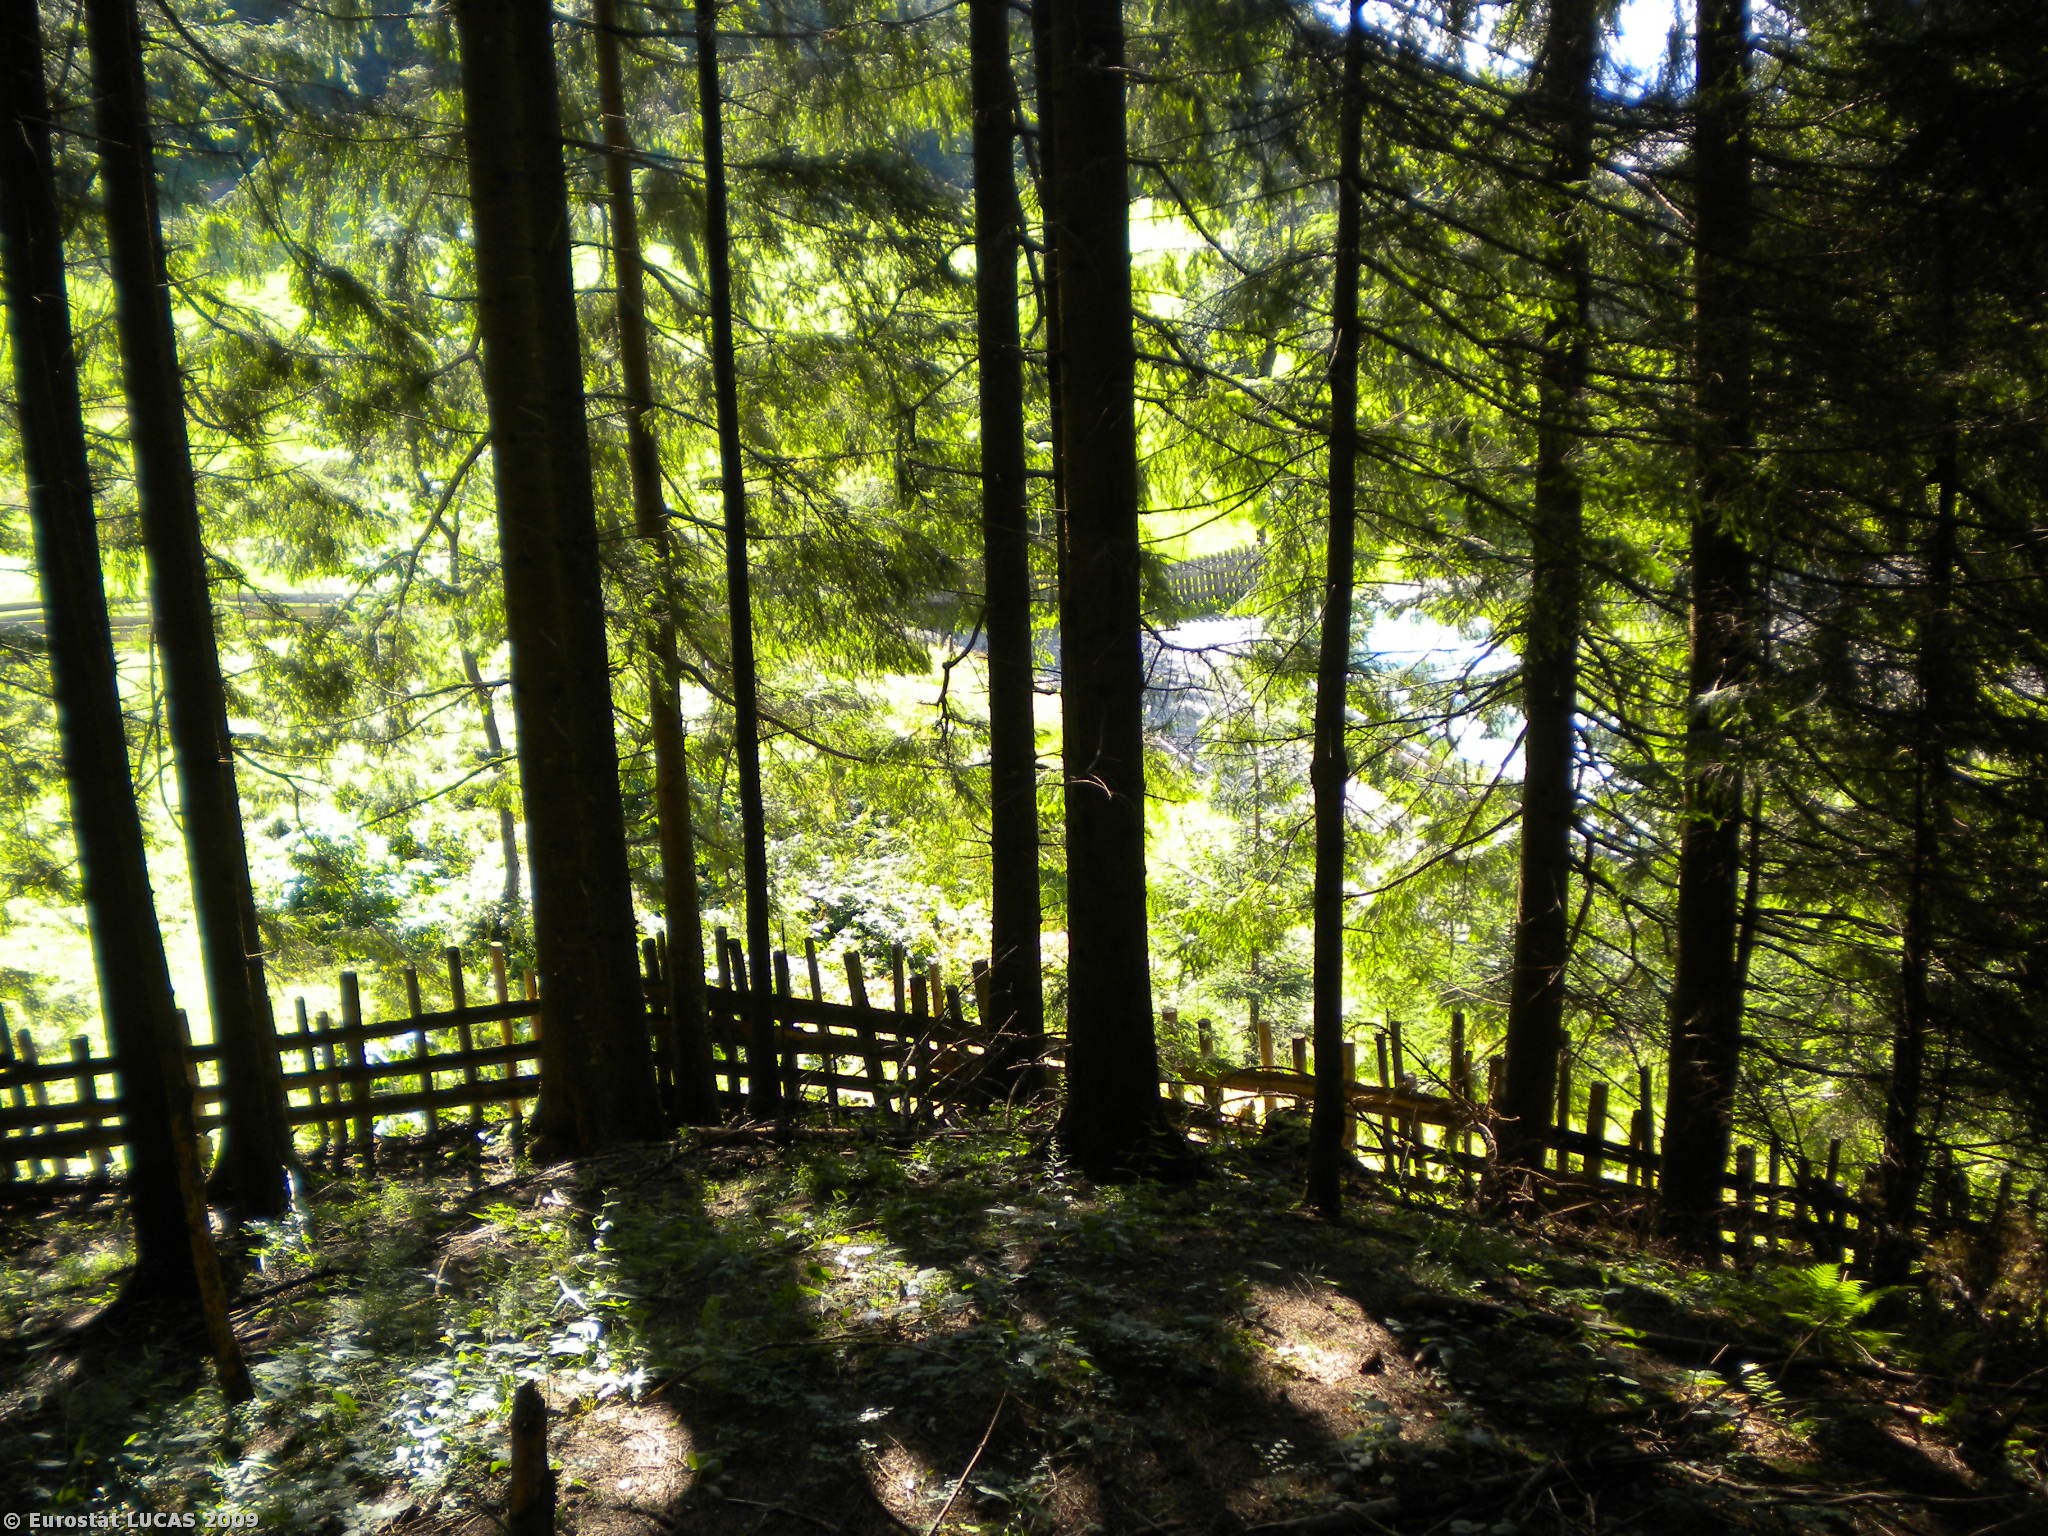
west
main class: Woodland
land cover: Coniferous woodland
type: alpine coniferous forest
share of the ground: > 75 %
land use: Forestry
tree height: > 5 m
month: July
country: AT
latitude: 46.6302
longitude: 13.1189
